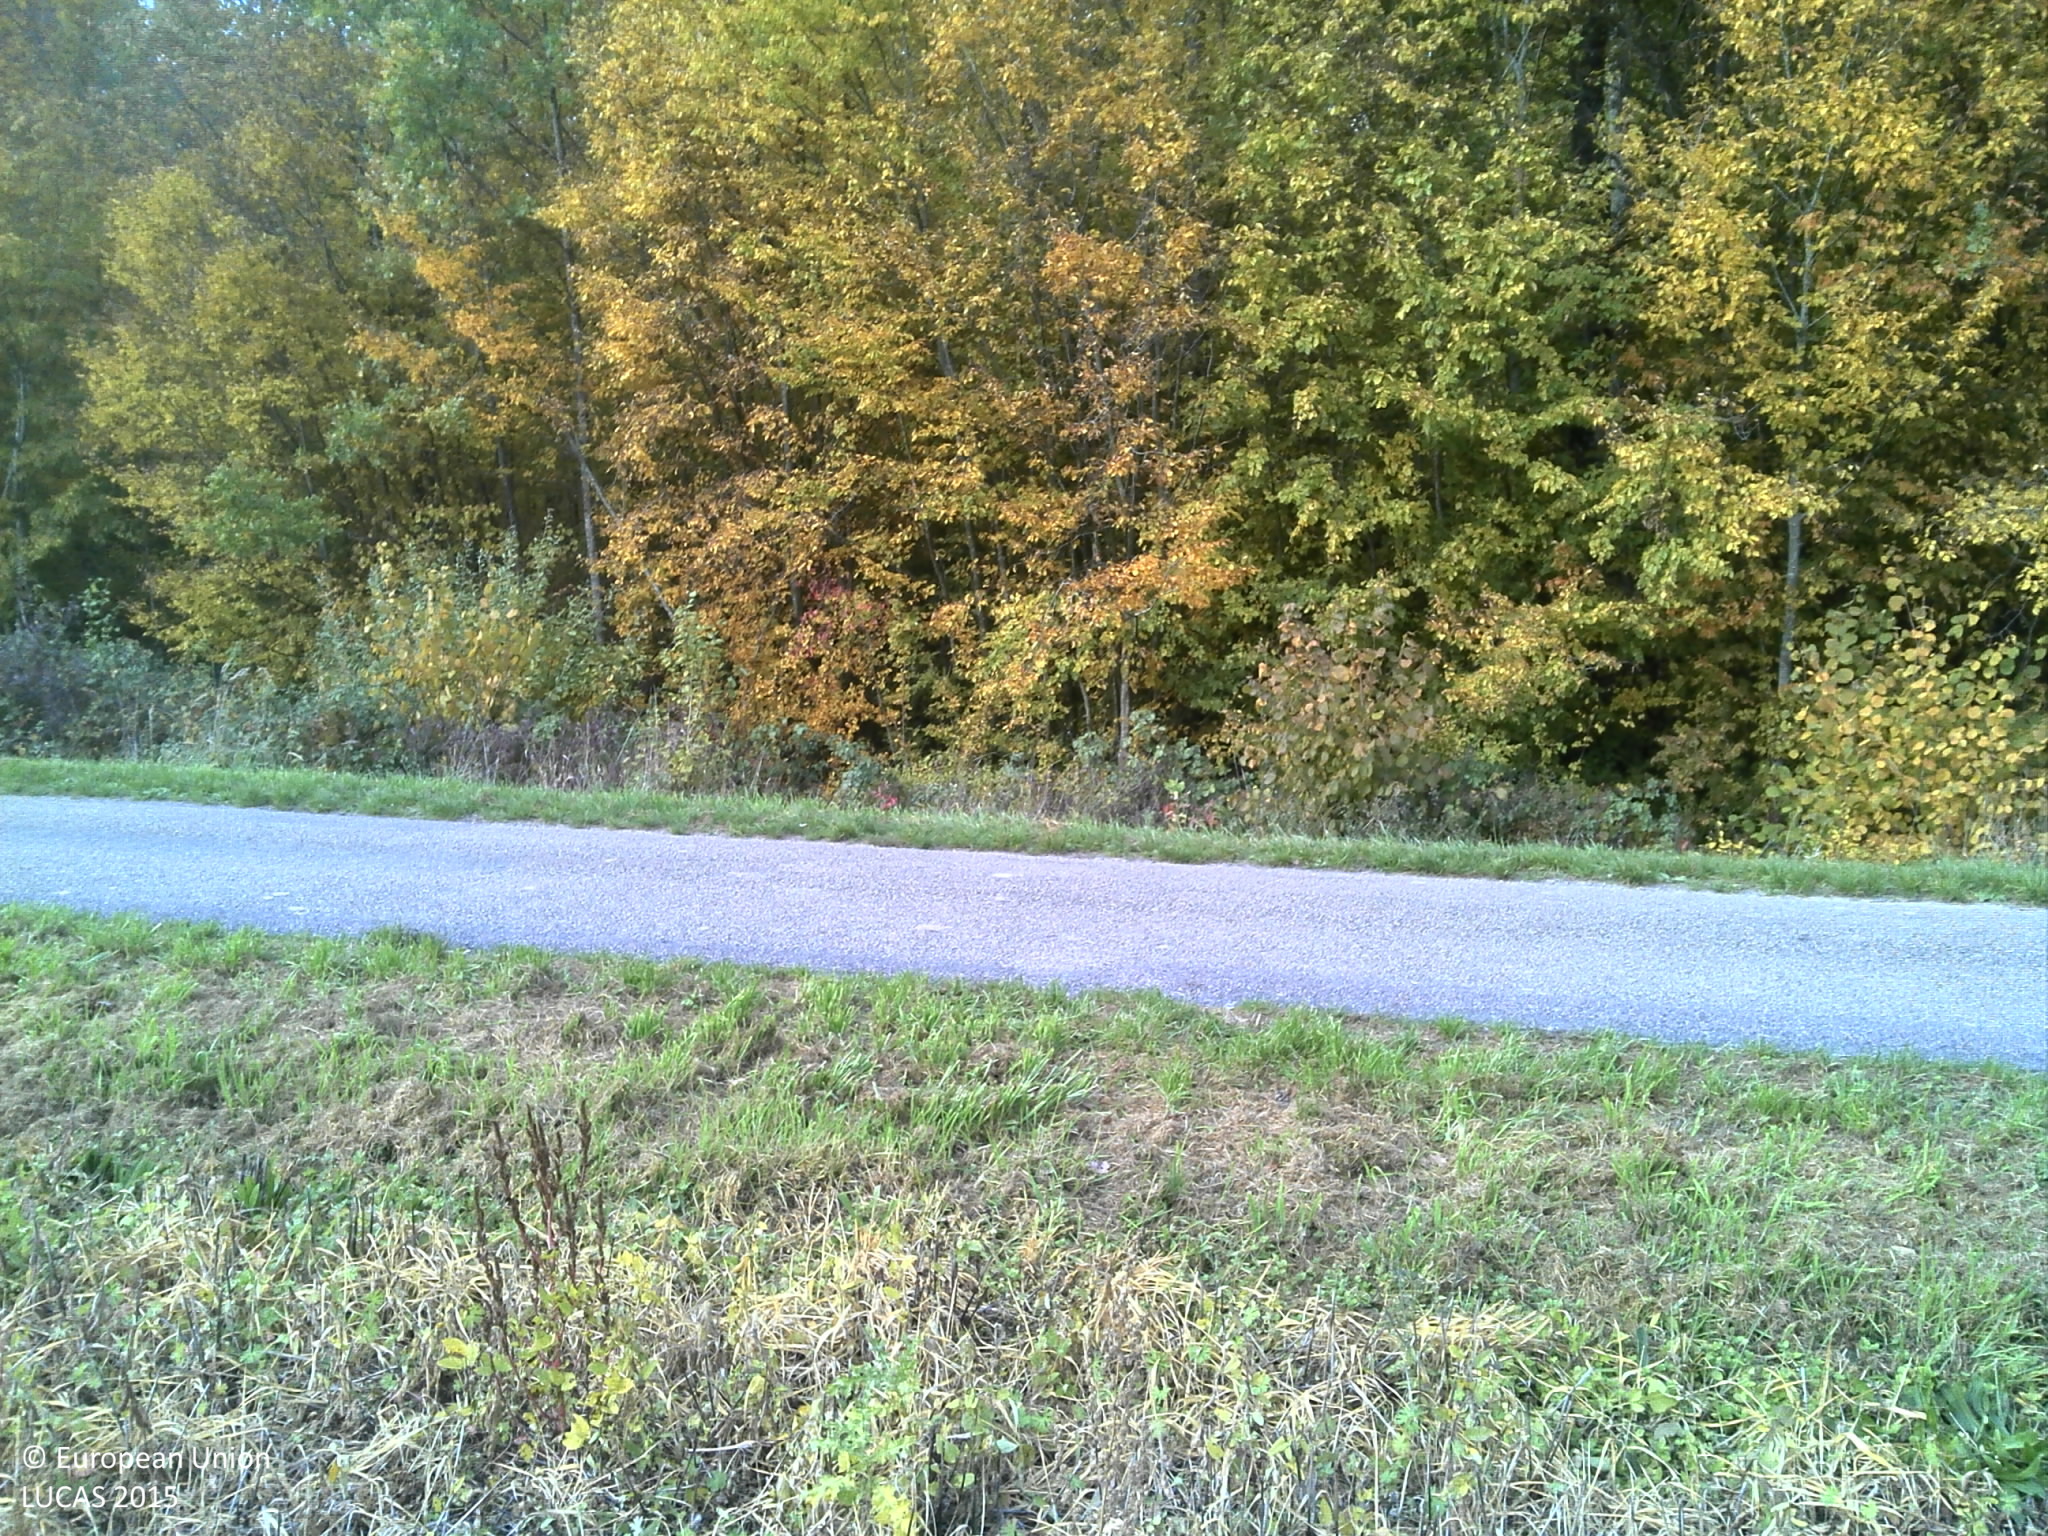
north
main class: Cropland
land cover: Common wheat
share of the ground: 50 - 75 %
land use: Agriculture (excluding fallow land and kitchen gardens)
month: October
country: FR
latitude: 47.0776
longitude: 5.2996
